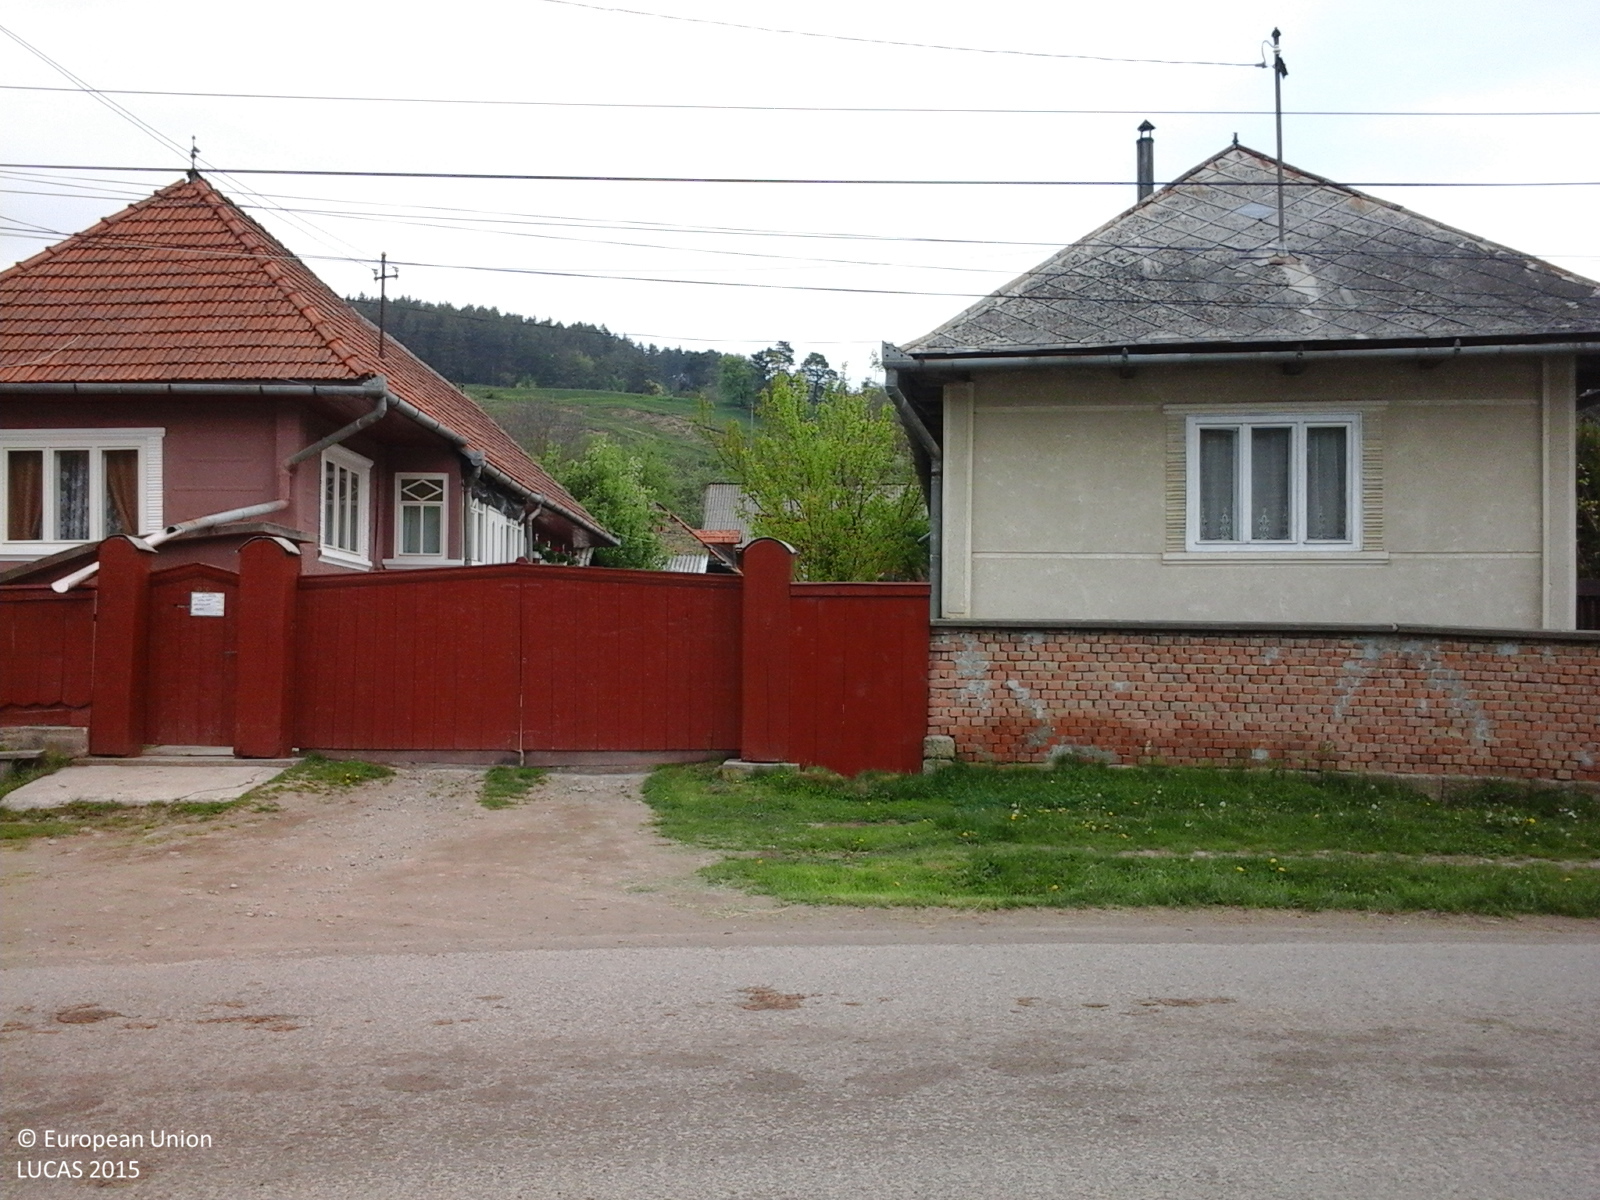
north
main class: Cropland
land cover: Apple fruit
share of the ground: 25 - 50 %
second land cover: Grassland without tree/shrub cover
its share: > 75 %
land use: Kitchen garden
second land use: Residential
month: May
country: RO
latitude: 45.9799
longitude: 26.0065
